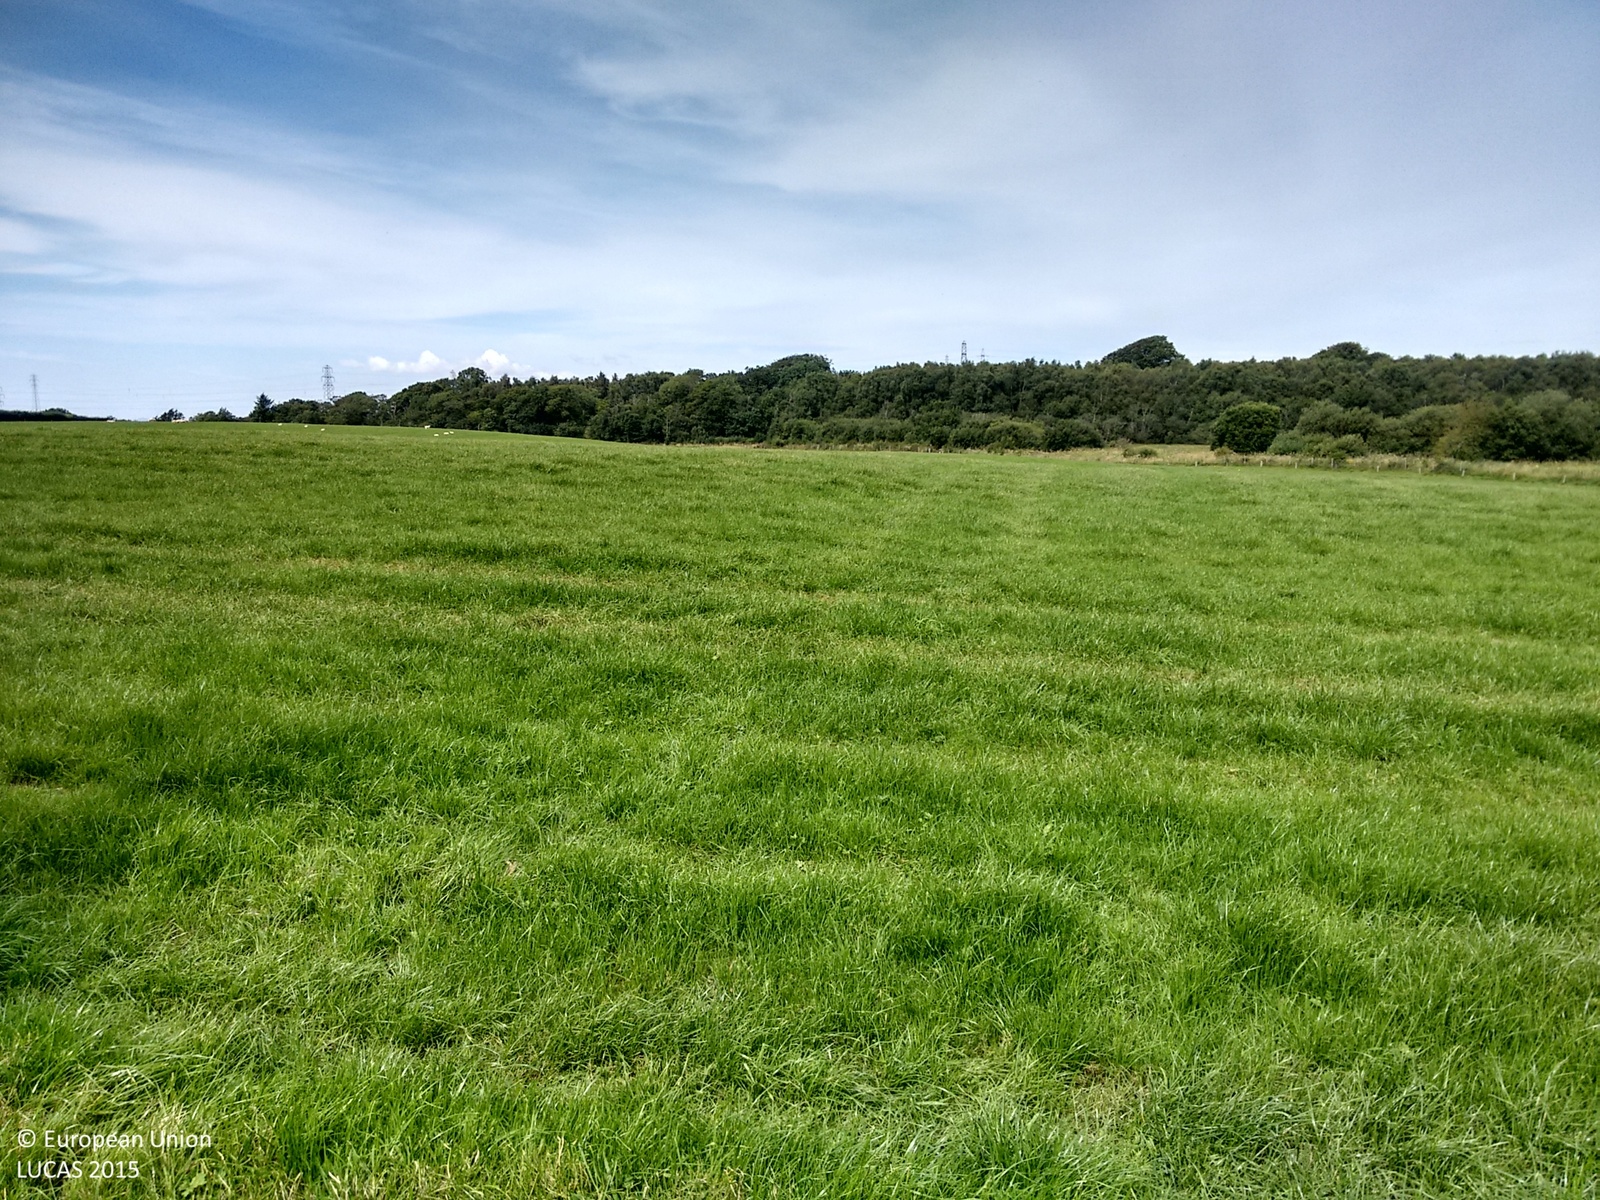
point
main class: Grassland
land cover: Grassland without tree/shrub cover
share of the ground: > 75 %
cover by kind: herbaceous plants 100 %
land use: Agriculture (excluding fallow land and kitchen gardens)
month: August
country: GB
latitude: 54.7788
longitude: -3.3084
